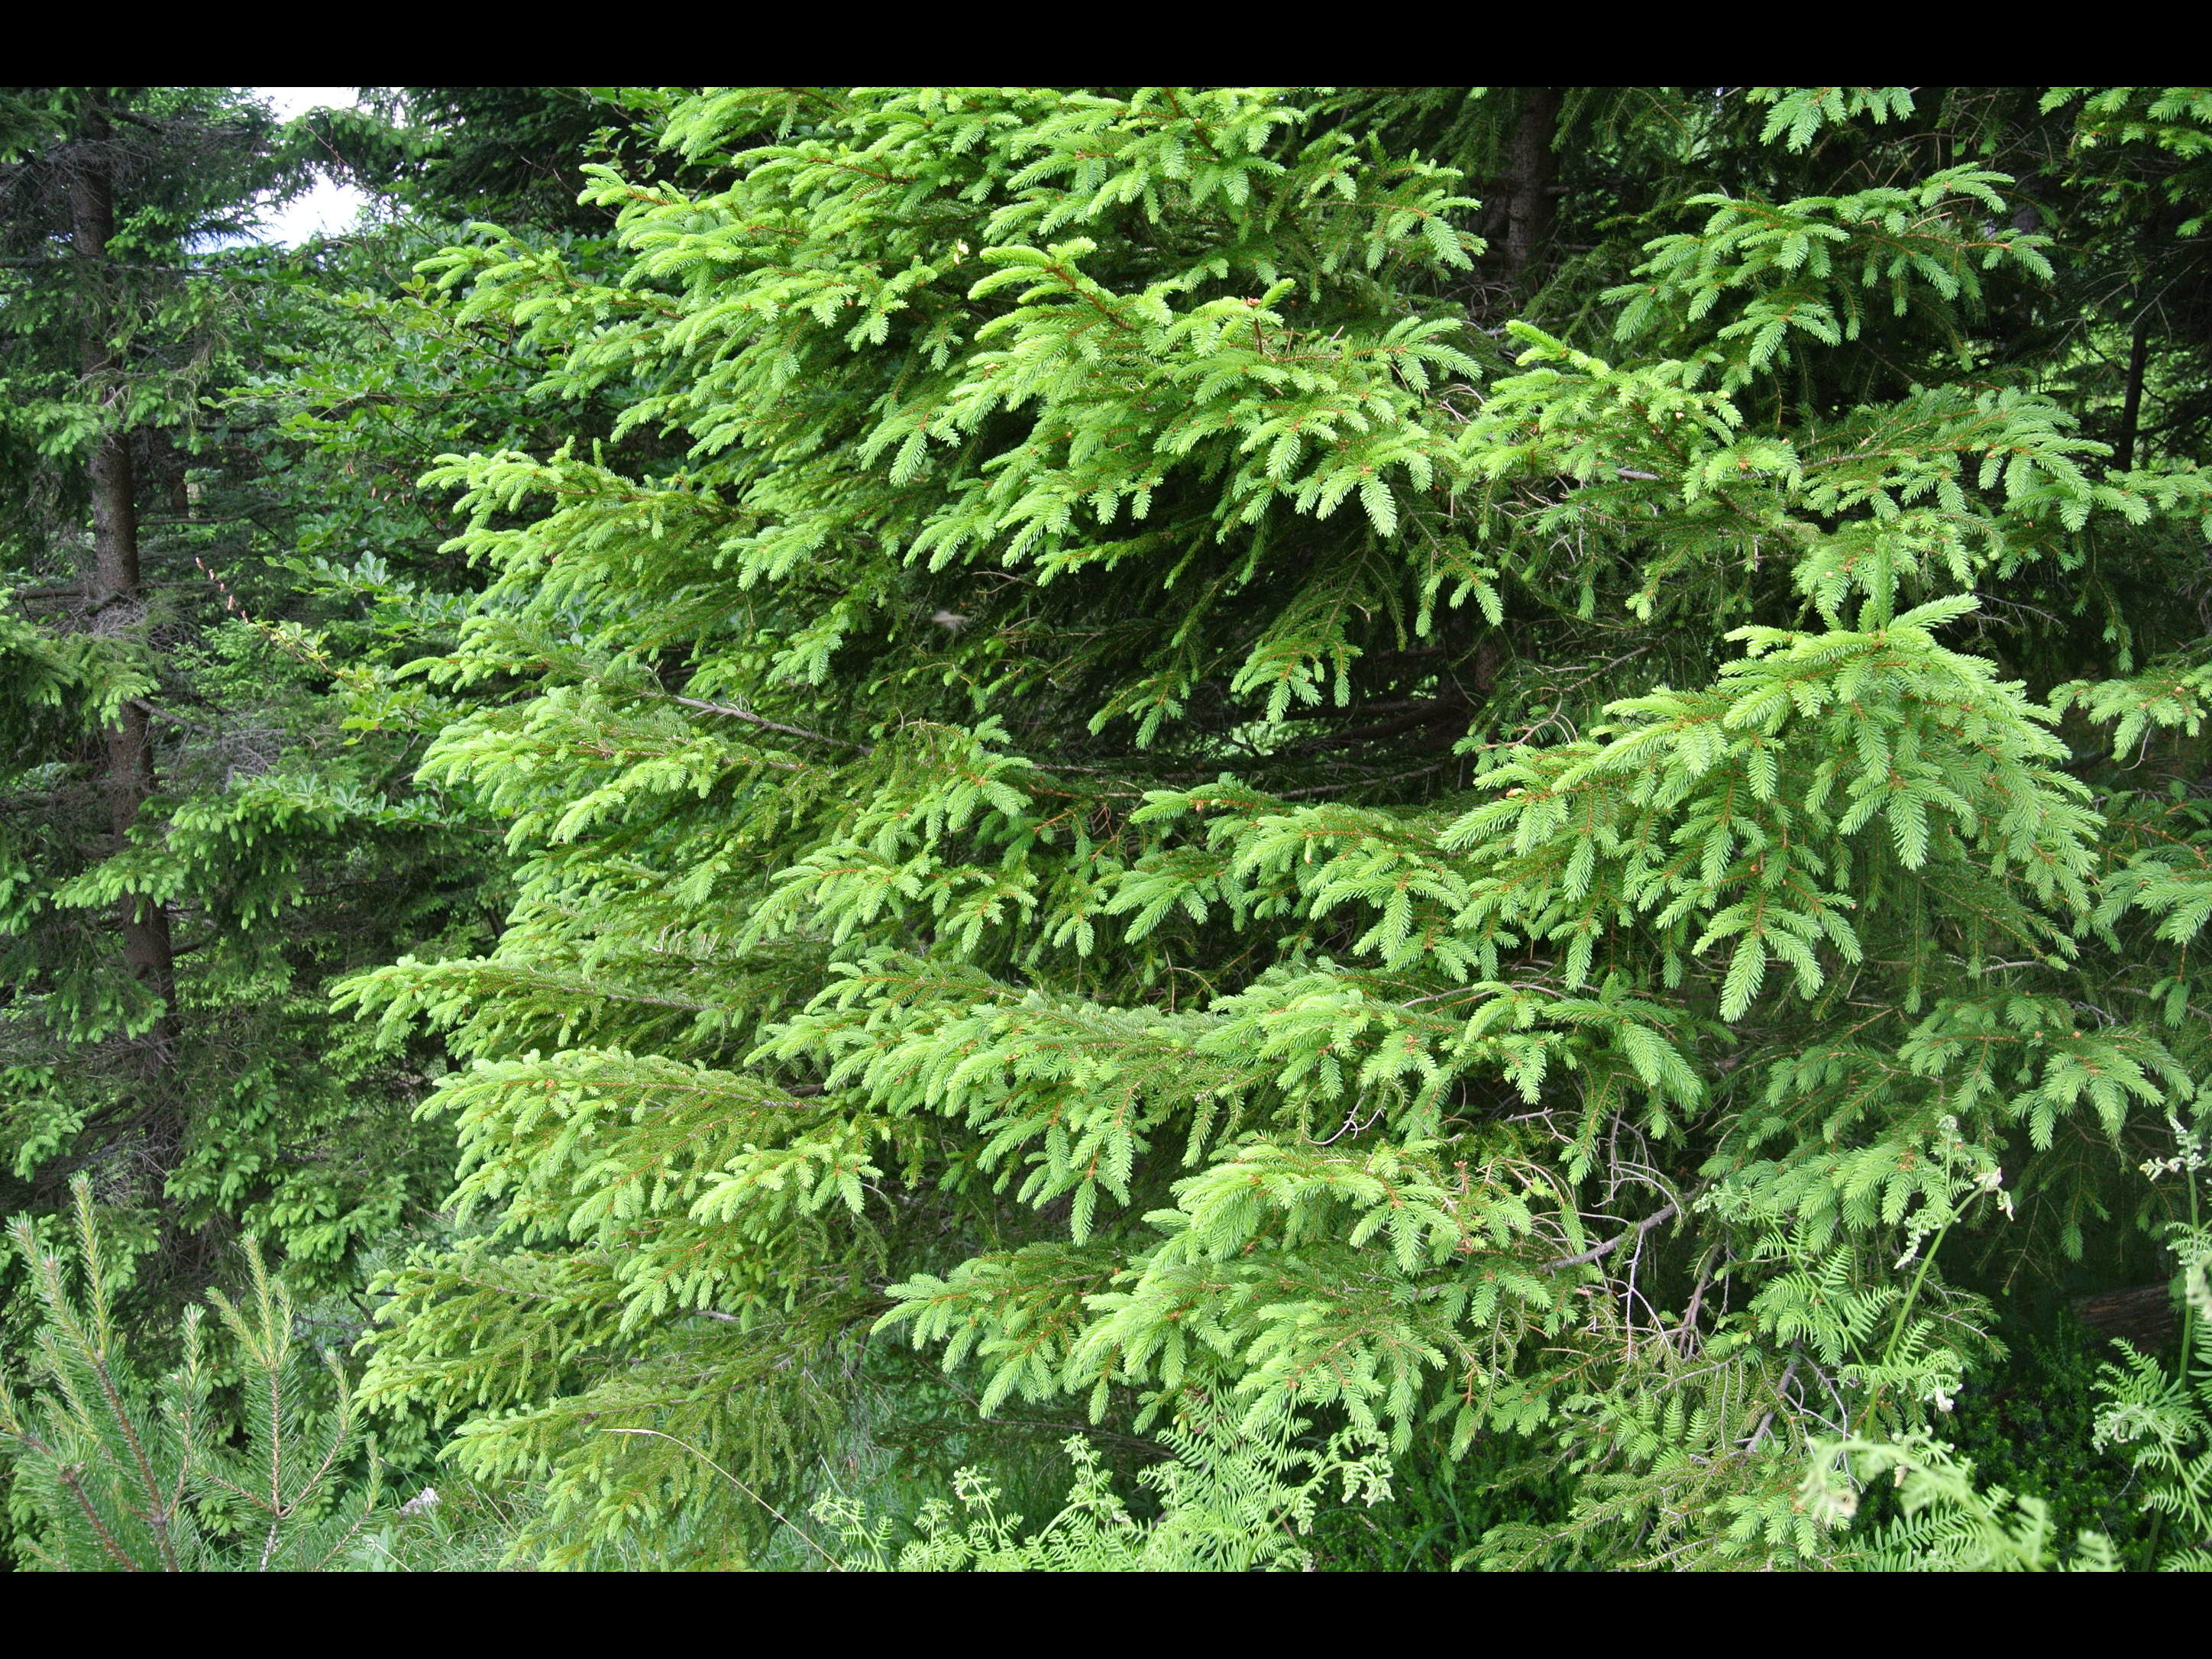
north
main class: Woodland
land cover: Spruce dominated coniferous woodland
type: alpine coniferous forest
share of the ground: > 75 %
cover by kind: coniferous forest trees 75 %, herbaceous plants 20 %, shrubs 5 %
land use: Forestry
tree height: < 5 m
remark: Clear cut
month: June
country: AT
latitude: 47.8549
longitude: 15.7896
